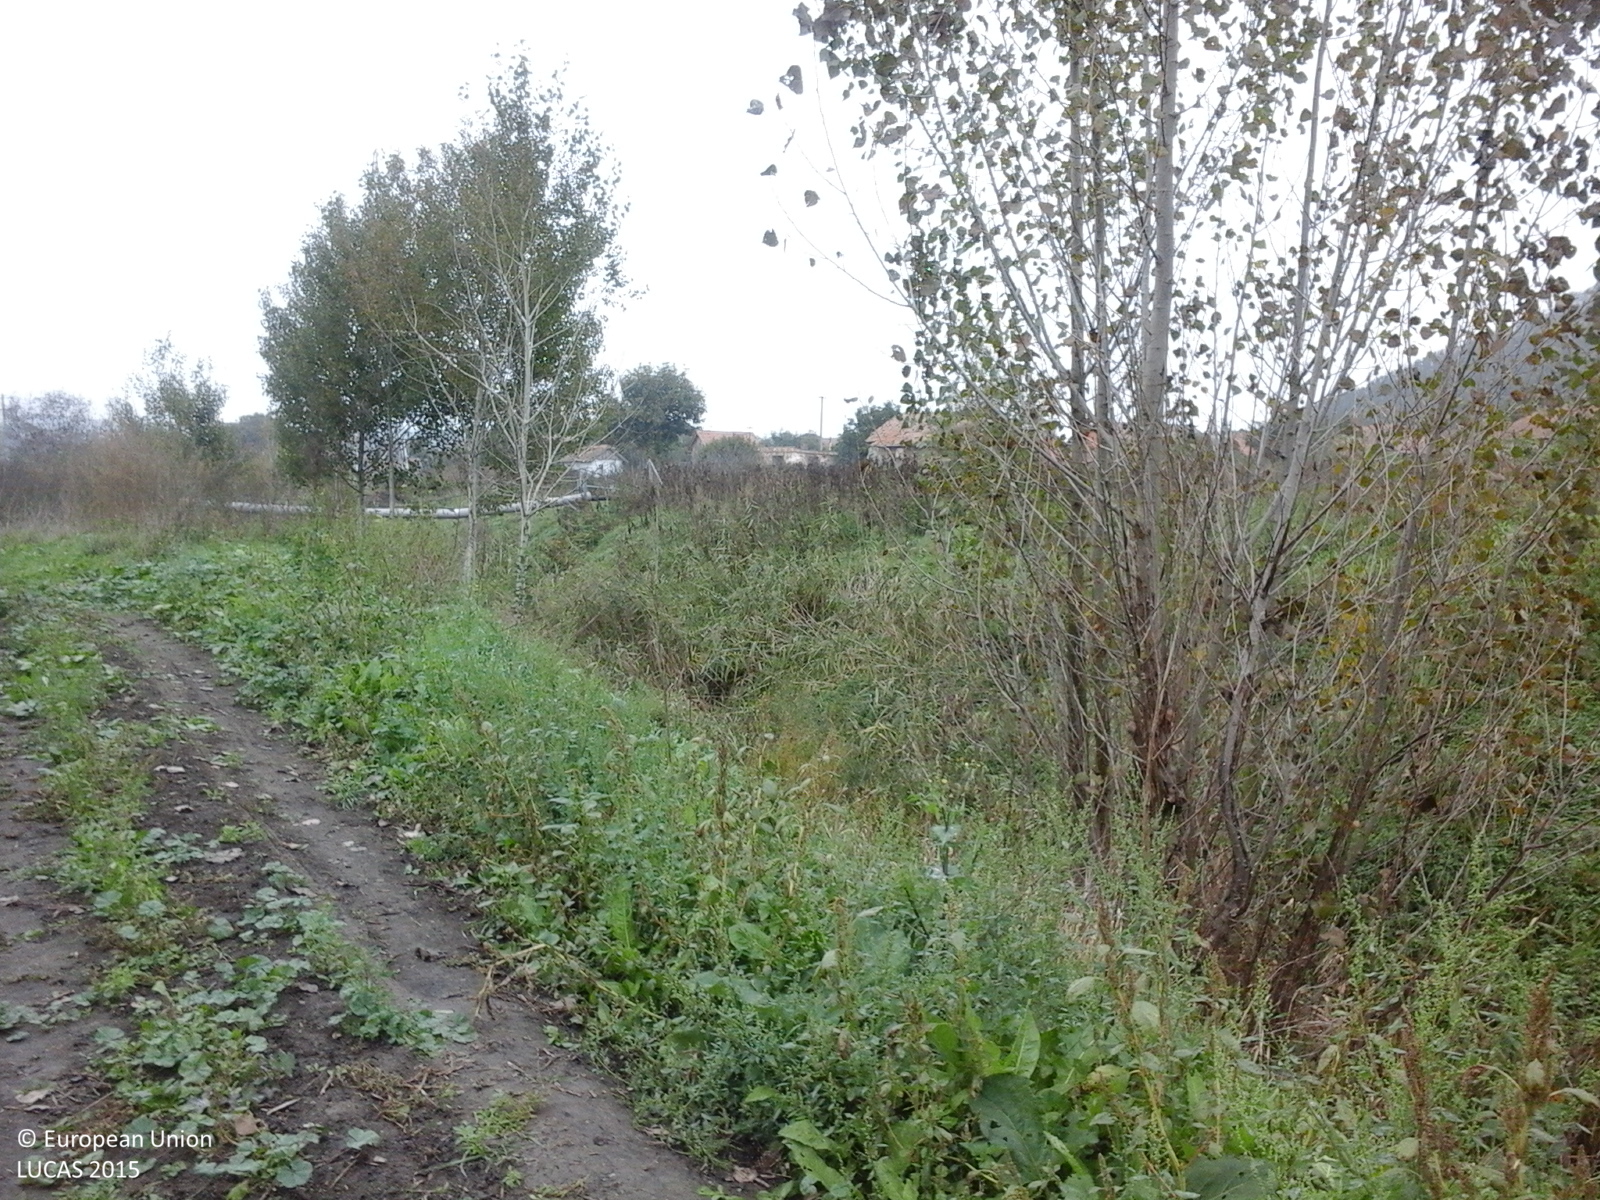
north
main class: Cropland
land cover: Maize
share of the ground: > 75 %
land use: Agriculture (excluding fallow land and kitchen gardens)
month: October
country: RO
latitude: 46.6865
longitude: 24.4032
